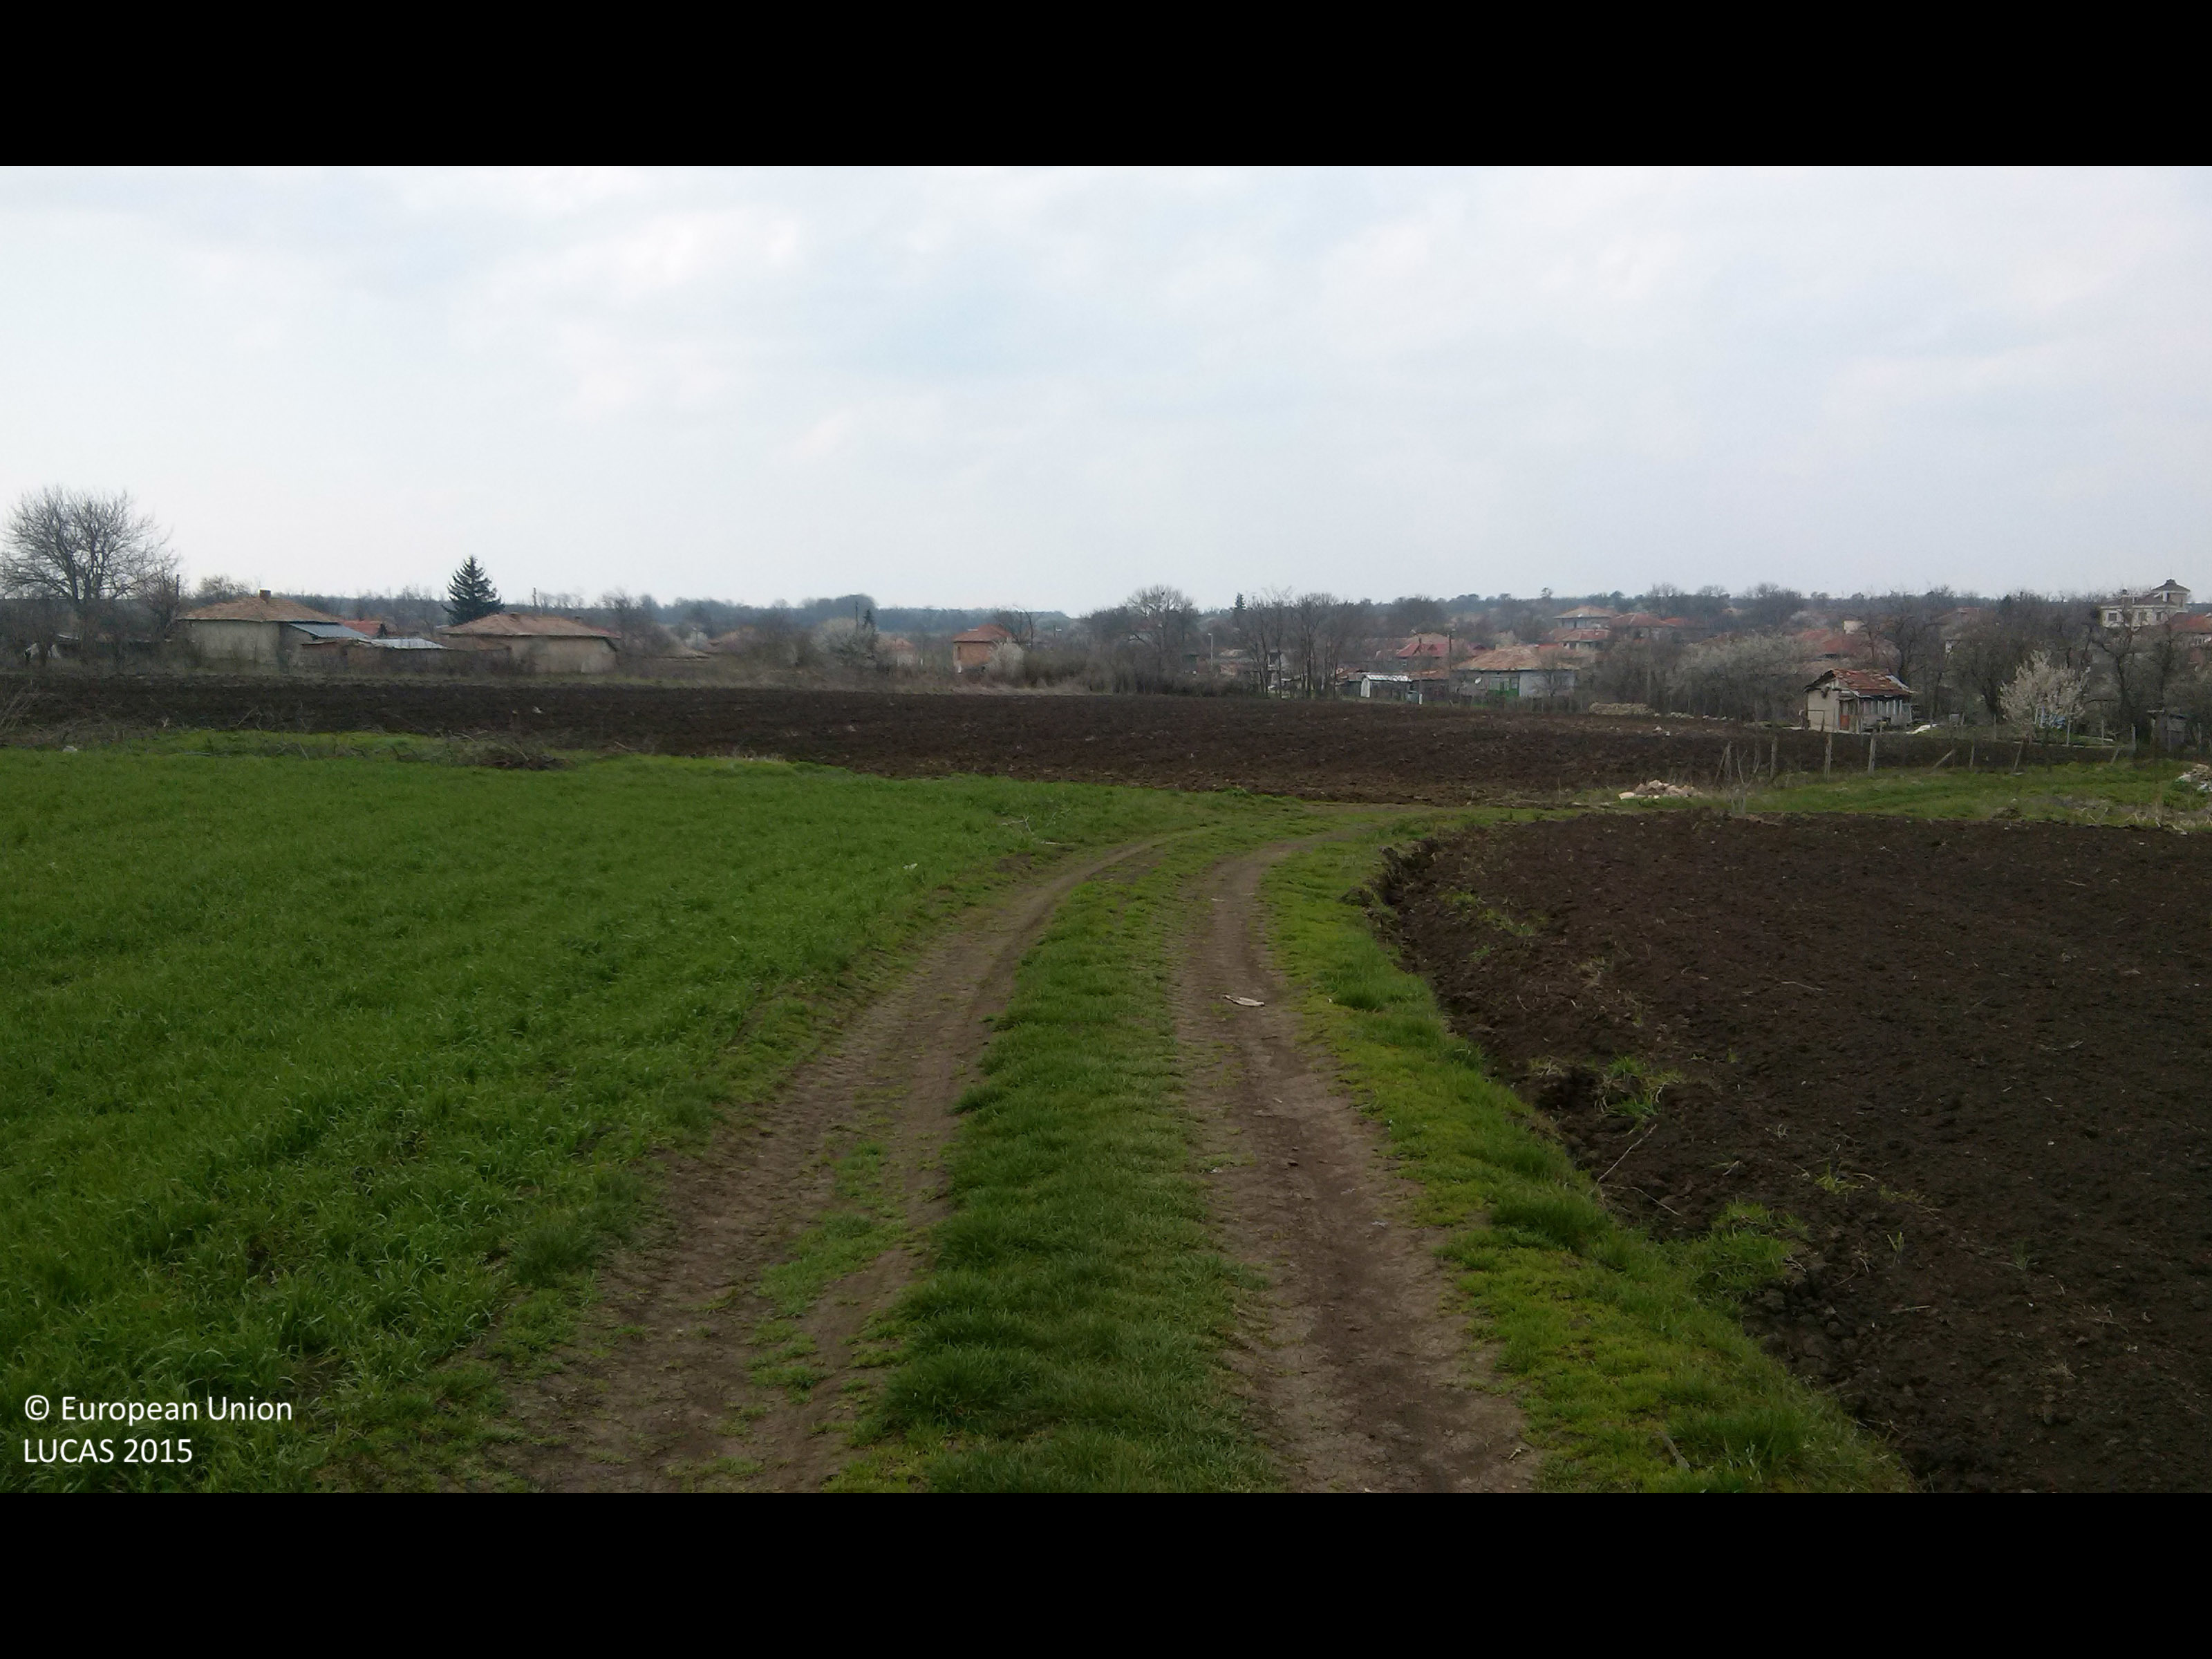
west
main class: Cropland
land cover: Oats
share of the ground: < 10 %
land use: Agriculture (excluding fallow land and kitchen gardens)
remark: Harvested field
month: June
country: BG
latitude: 43.3951
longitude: 26.8917
